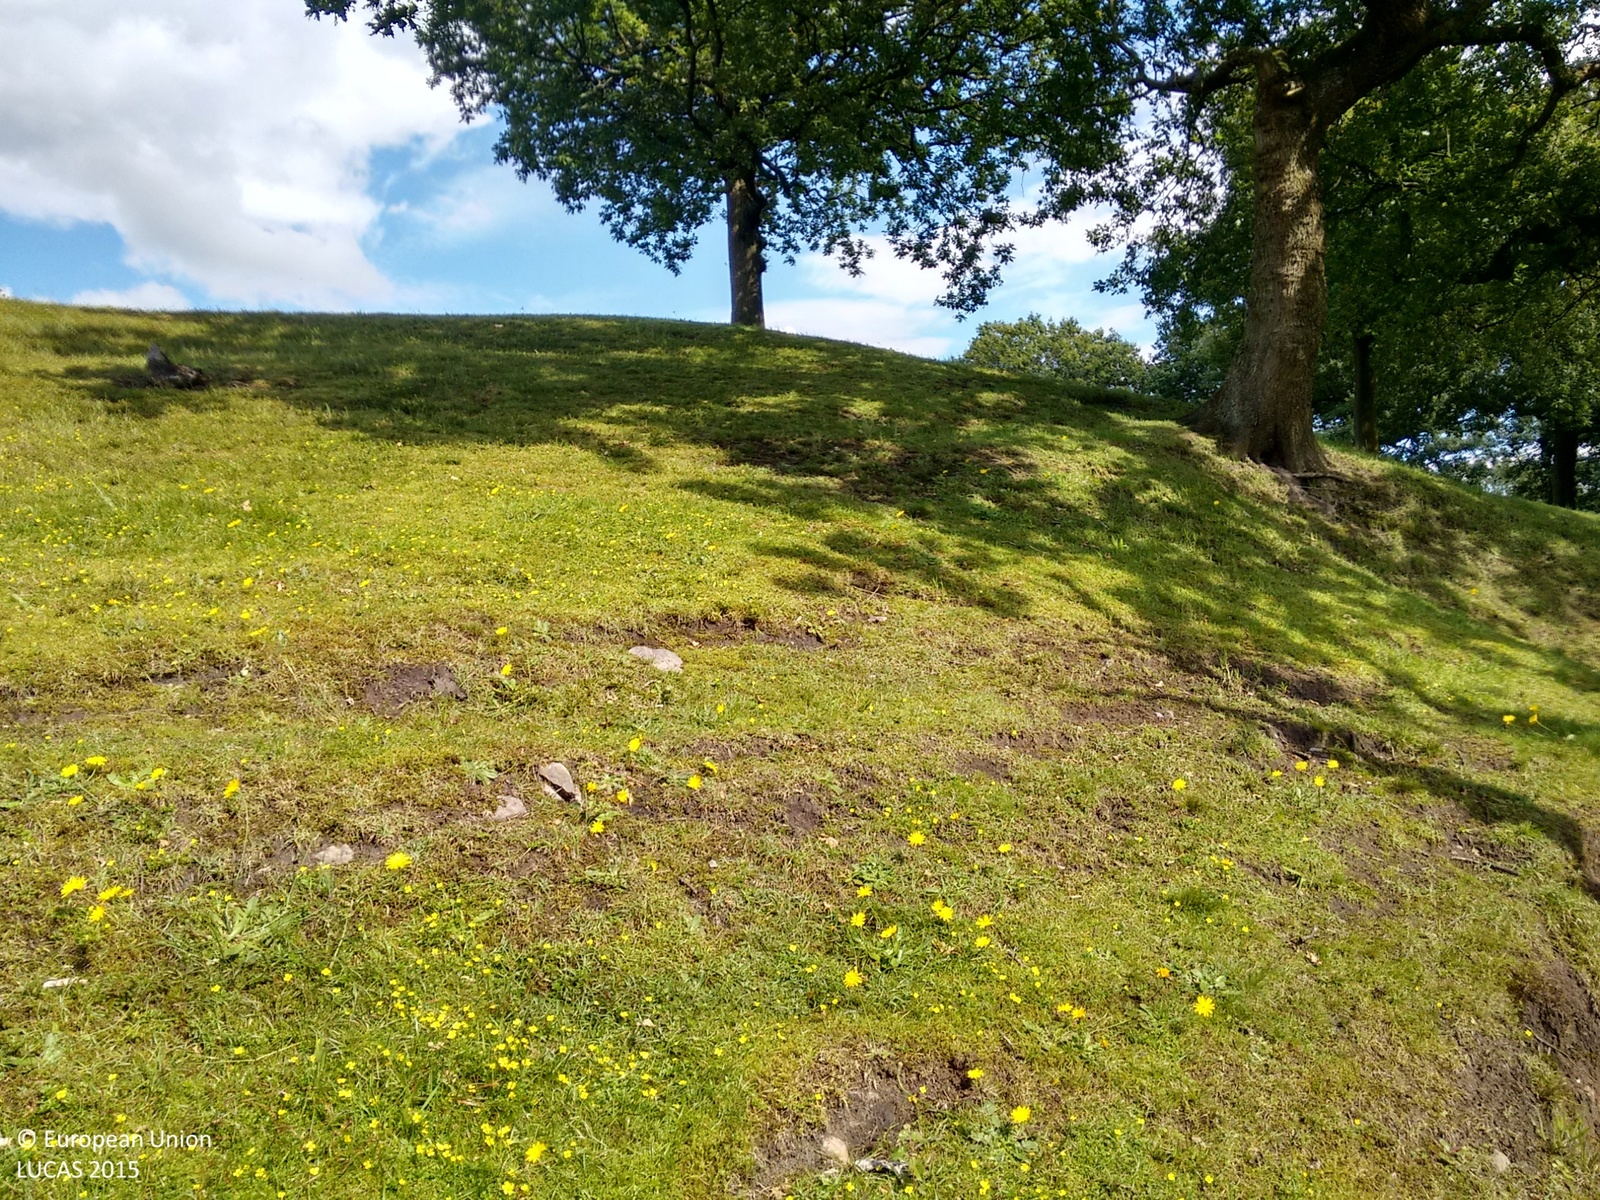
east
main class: Woodland
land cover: Broadleaved woodland
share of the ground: > 75 %
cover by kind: herbaceous plants 80 %, broadleaved forest trees 15 %, unconsolidated bare surface 5 %
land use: Amenities, museums, leisure
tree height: > 5 m
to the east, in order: Broadleaved woodland; Grassland with sparse tree/shrub cover; Artificial constructions; Grassland without tree/shrub cover; Artificial constructions; Grassland without tree/shrub cover; Artificial constructions; Grassland without tree/shrub cover; Fences; Broadleaved woodland
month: August
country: GB
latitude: 55.9974
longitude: -3.8572
